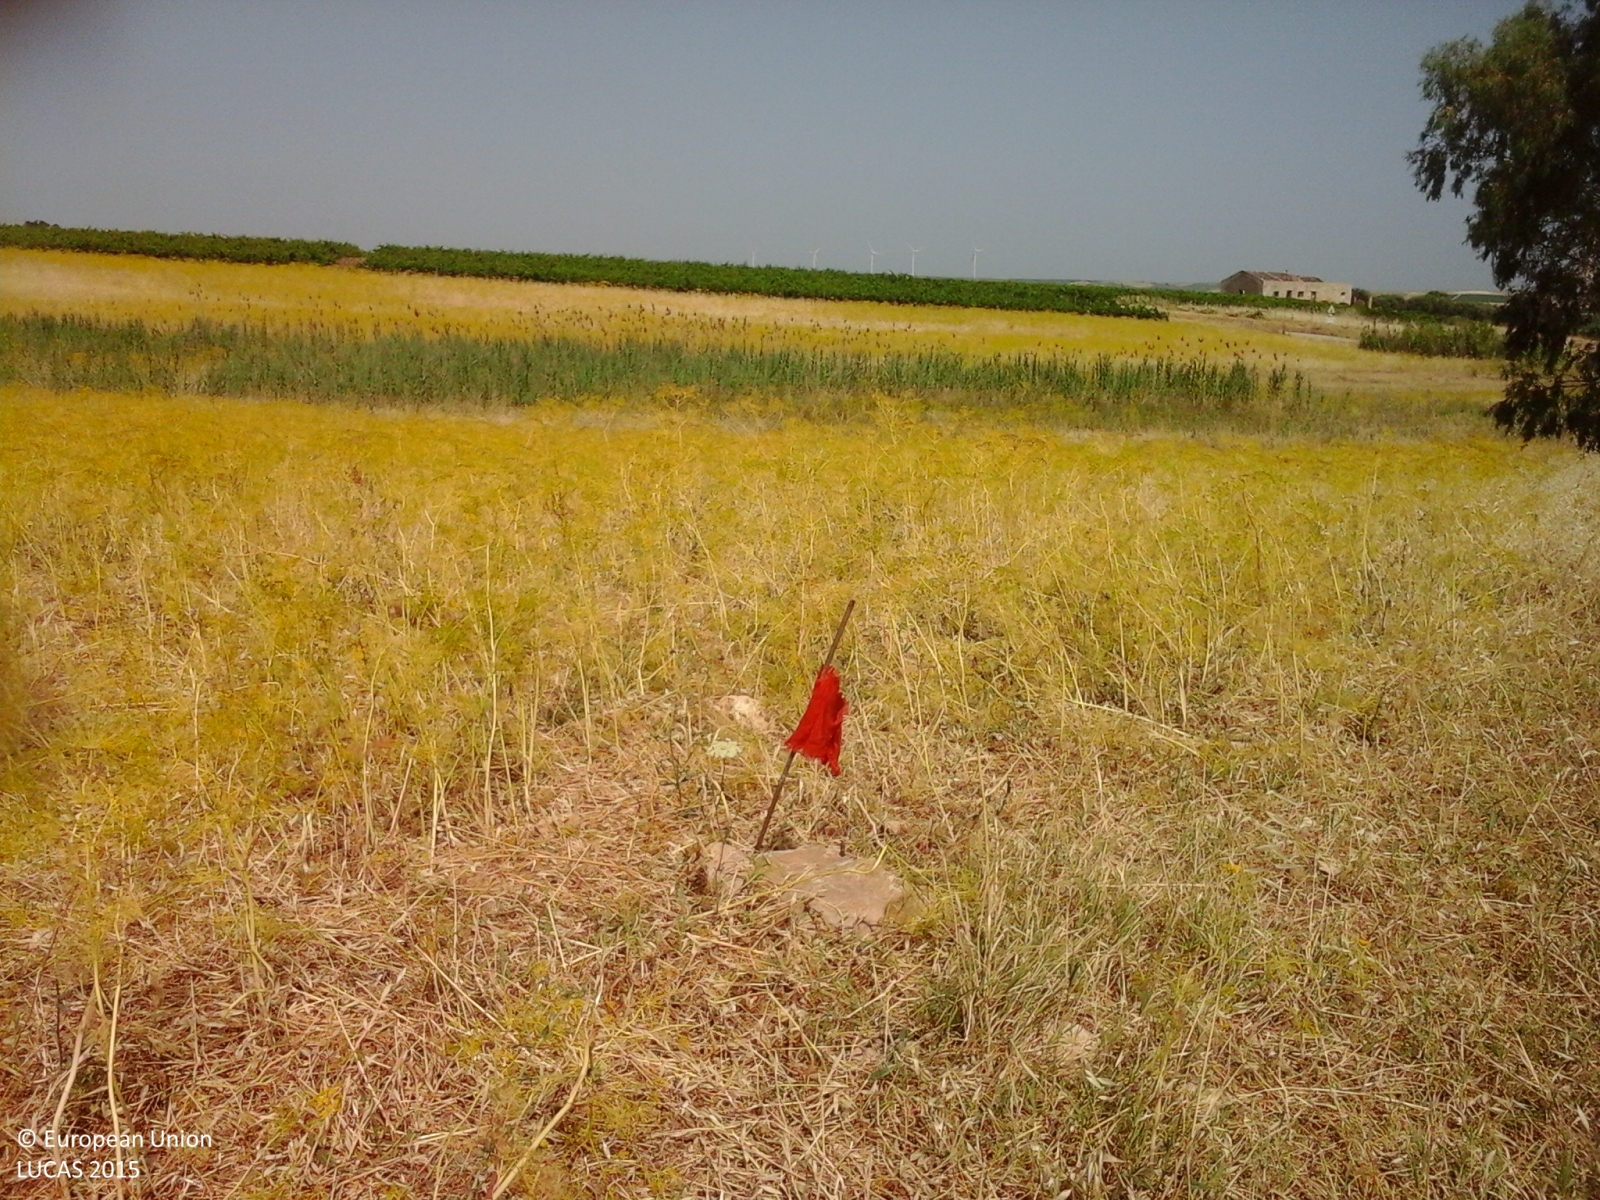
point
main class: Grassland
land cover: Spontaneously vegetated surfaces
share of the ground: > 75 %
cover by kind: herbaceous plants 100 %
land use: Agriculture (excluding fallow land and kitchen gardens)
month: June
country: IT
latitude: 37.7464
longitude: 12.6697
